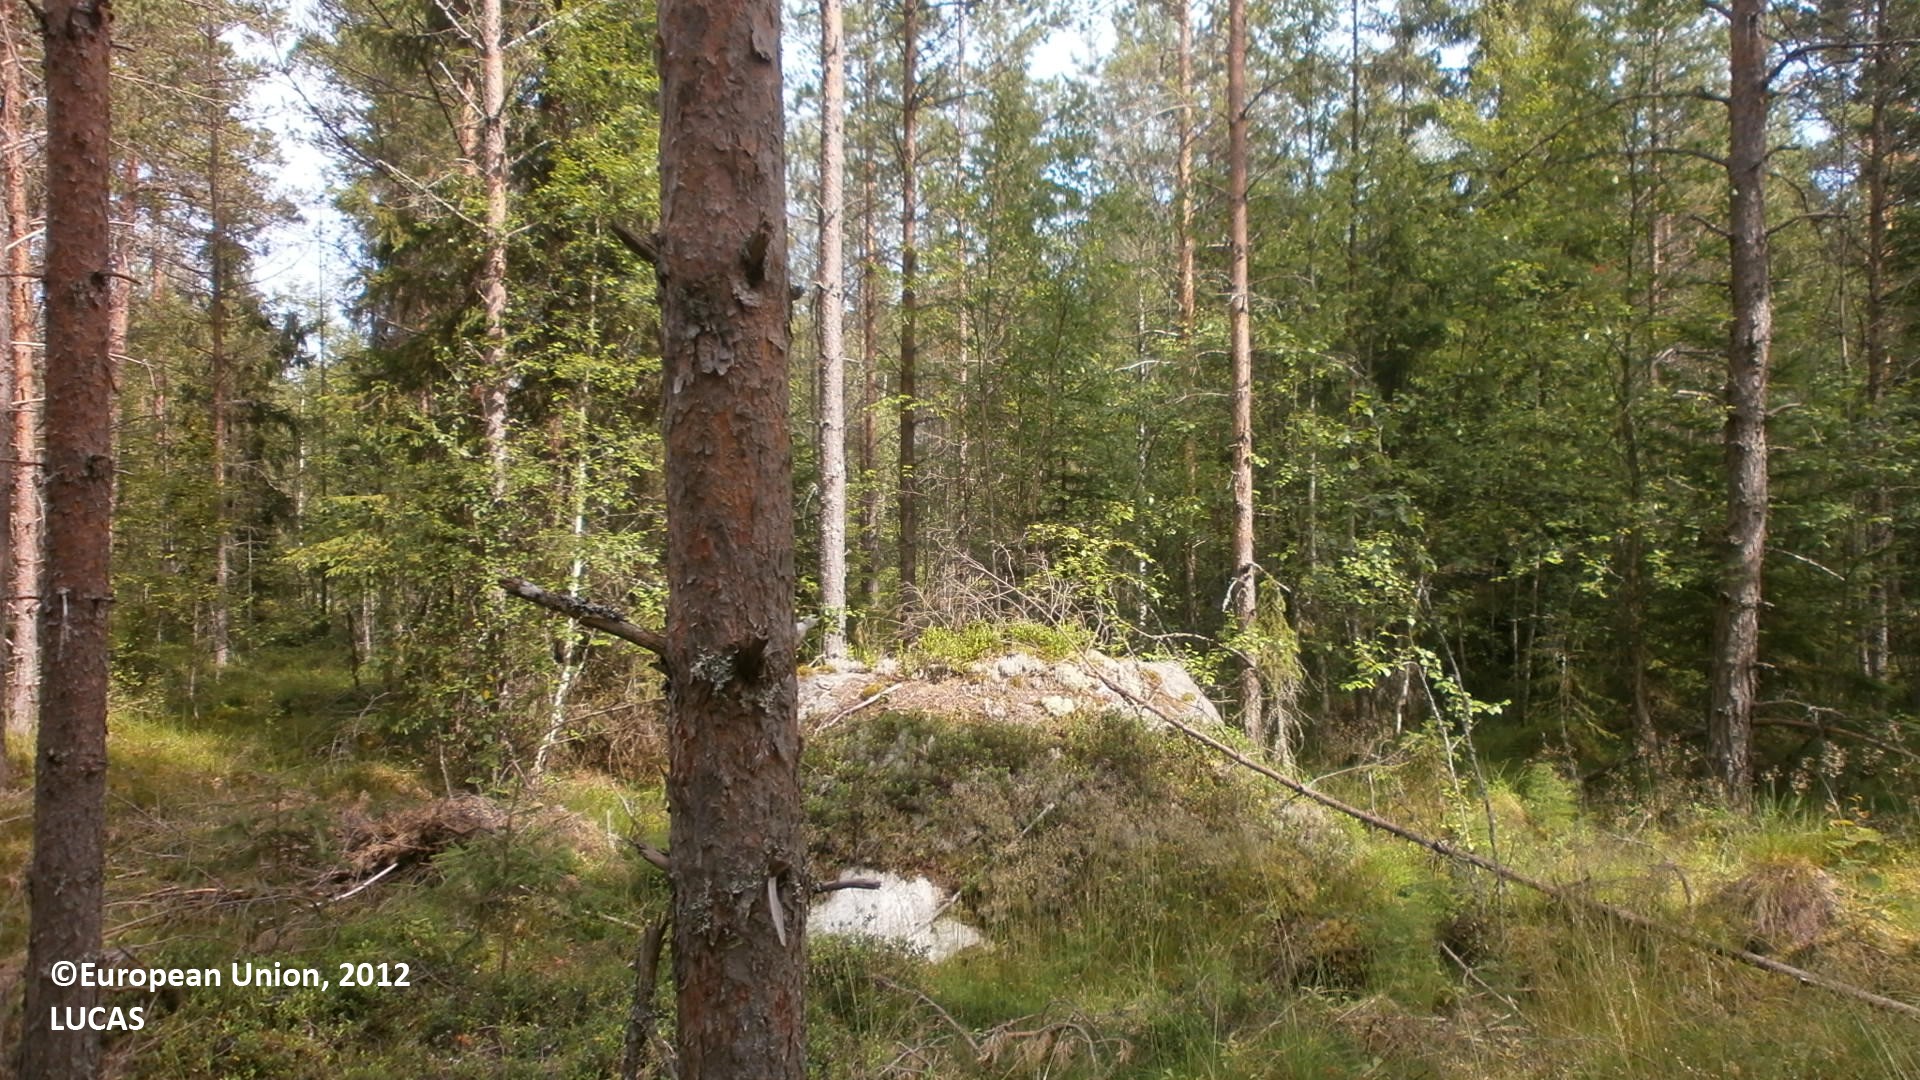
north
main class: Woodland
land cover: Pine dominated coniferous woodland
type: boreal forest
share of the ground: 50 - 75 %
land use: Forestry
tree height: > 5 m
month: July
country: FI
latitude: 64.0592
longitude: 23.8931
